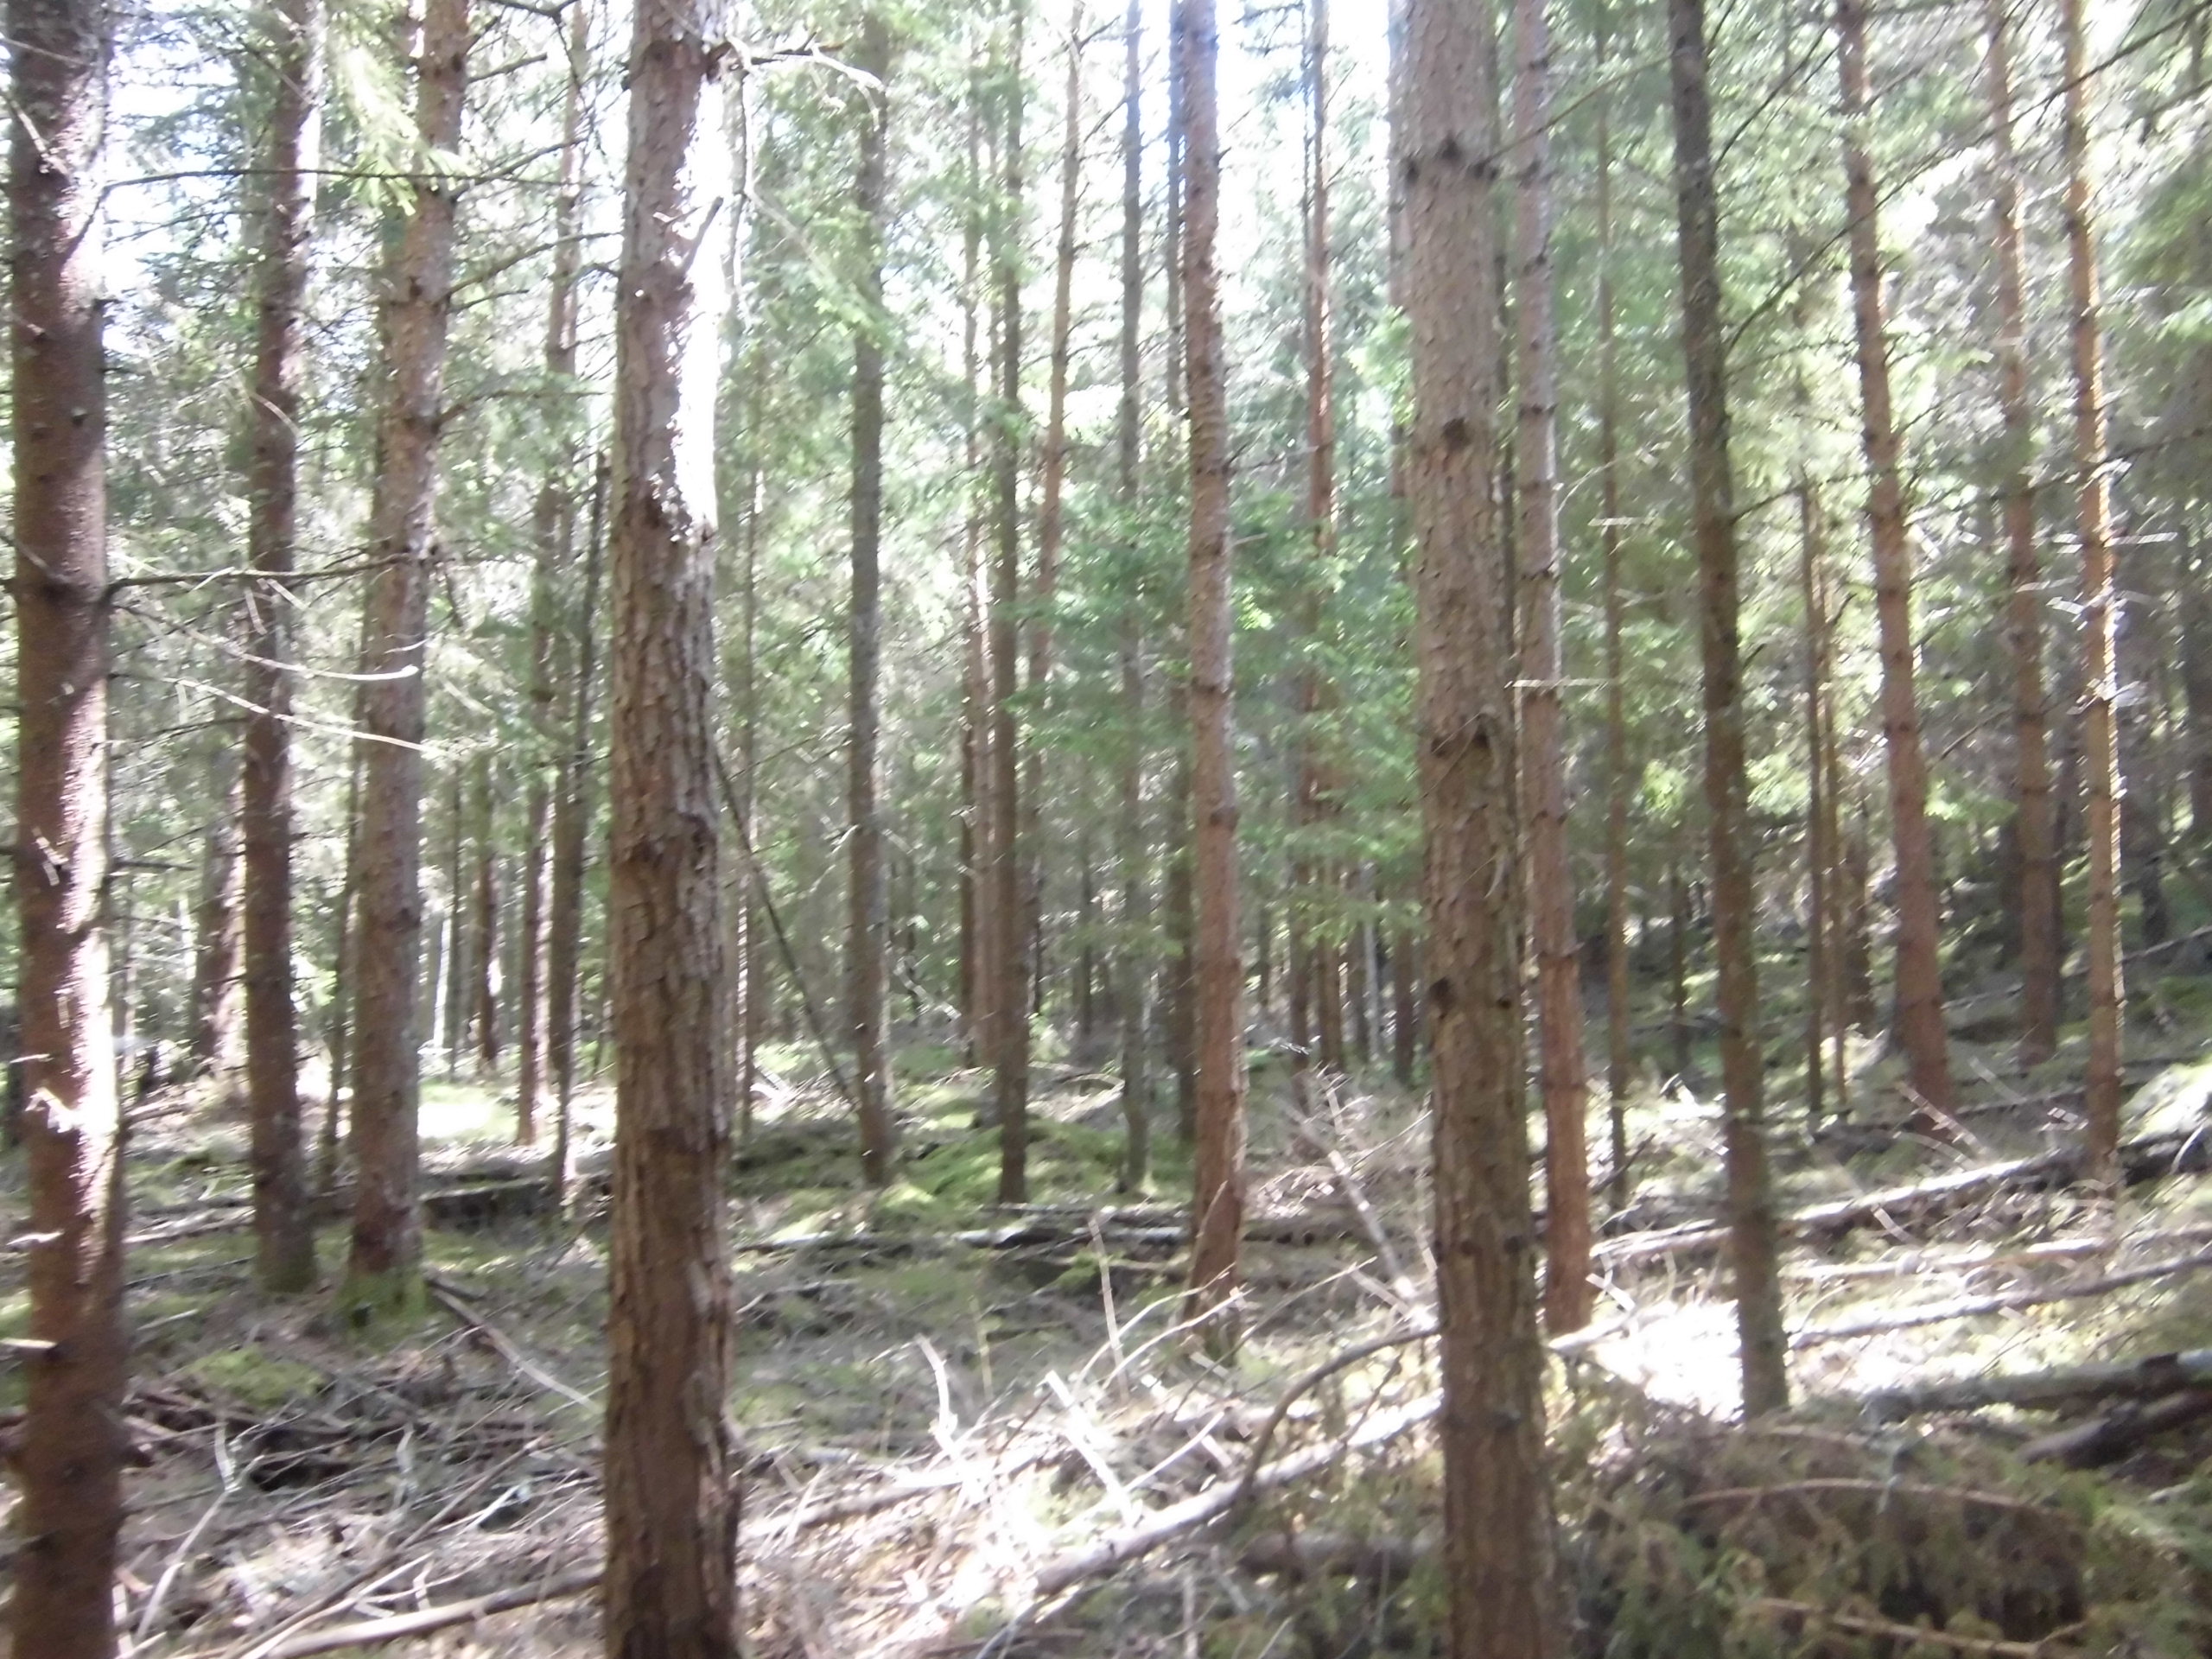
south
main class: Woodland
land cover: Pine dominated coniferous woodland
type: boreal forest
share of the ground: 50 - 75 %
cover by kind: coniferous forest trees 60 %, lichens and mosses 25 %, shrubs 10 %, herbaceous plants 5 %
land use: Forestry
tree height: > 5 m
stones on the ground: < 10 %
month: July
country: SE
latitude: 57.2915
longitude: 15.1571
